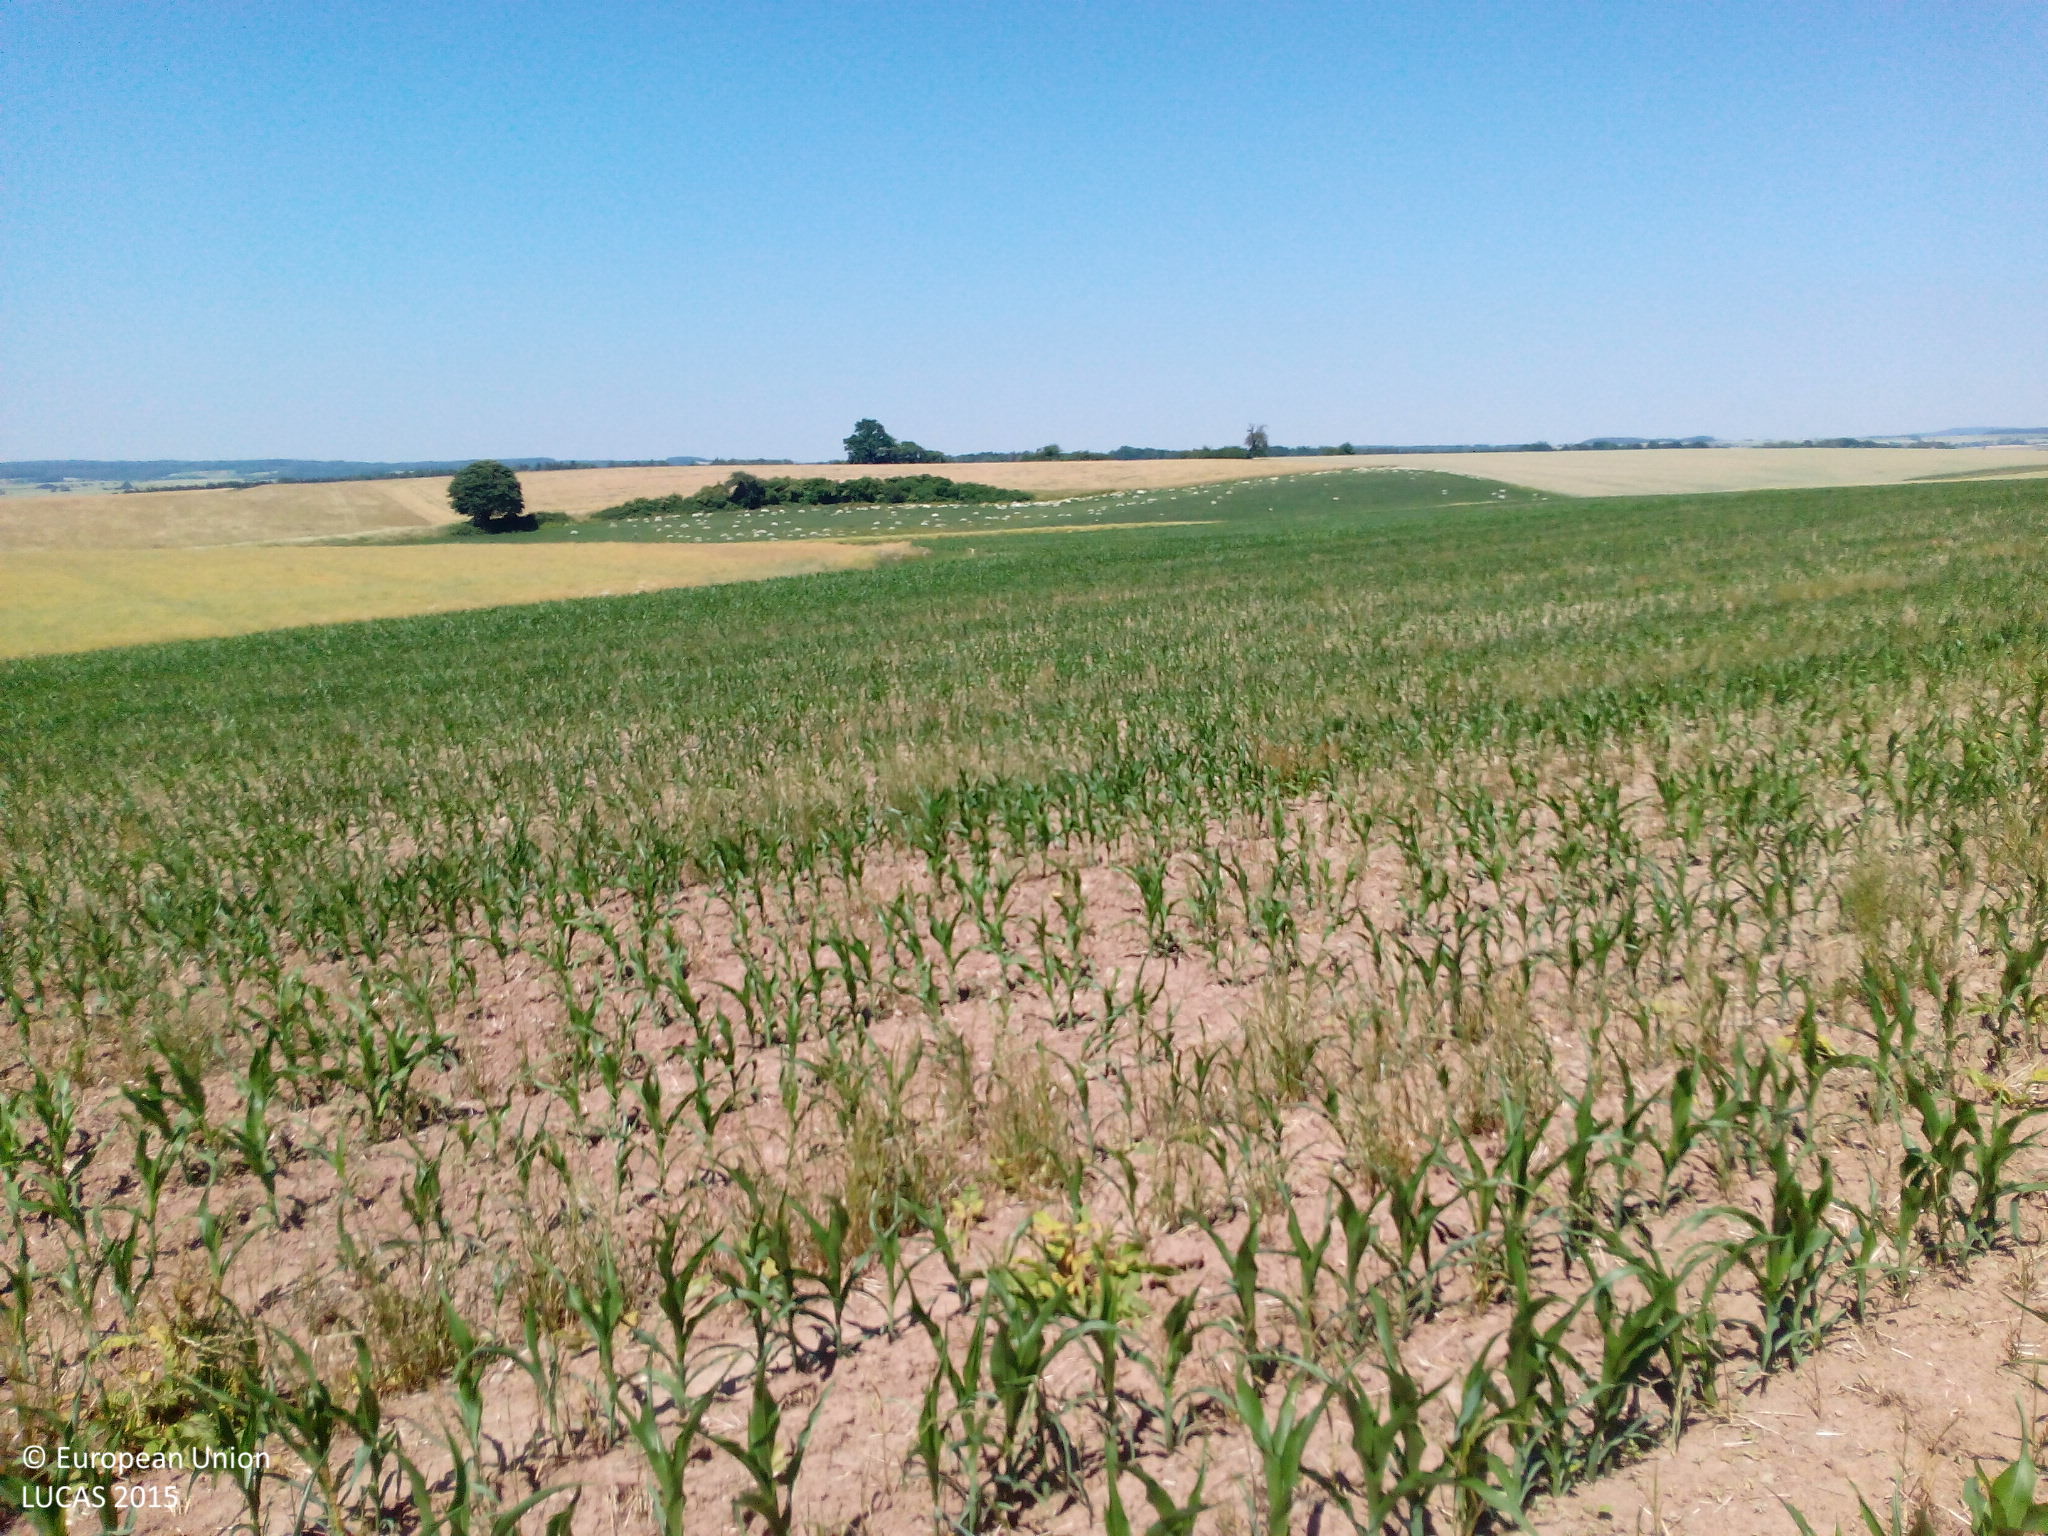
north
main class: Cropland
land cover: Maize
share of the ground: 25 - 50 %
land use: Agriculture (excluding fallow land and kitchen gardens)
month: July
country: DE
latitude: 50.3071
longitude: 10.8282
